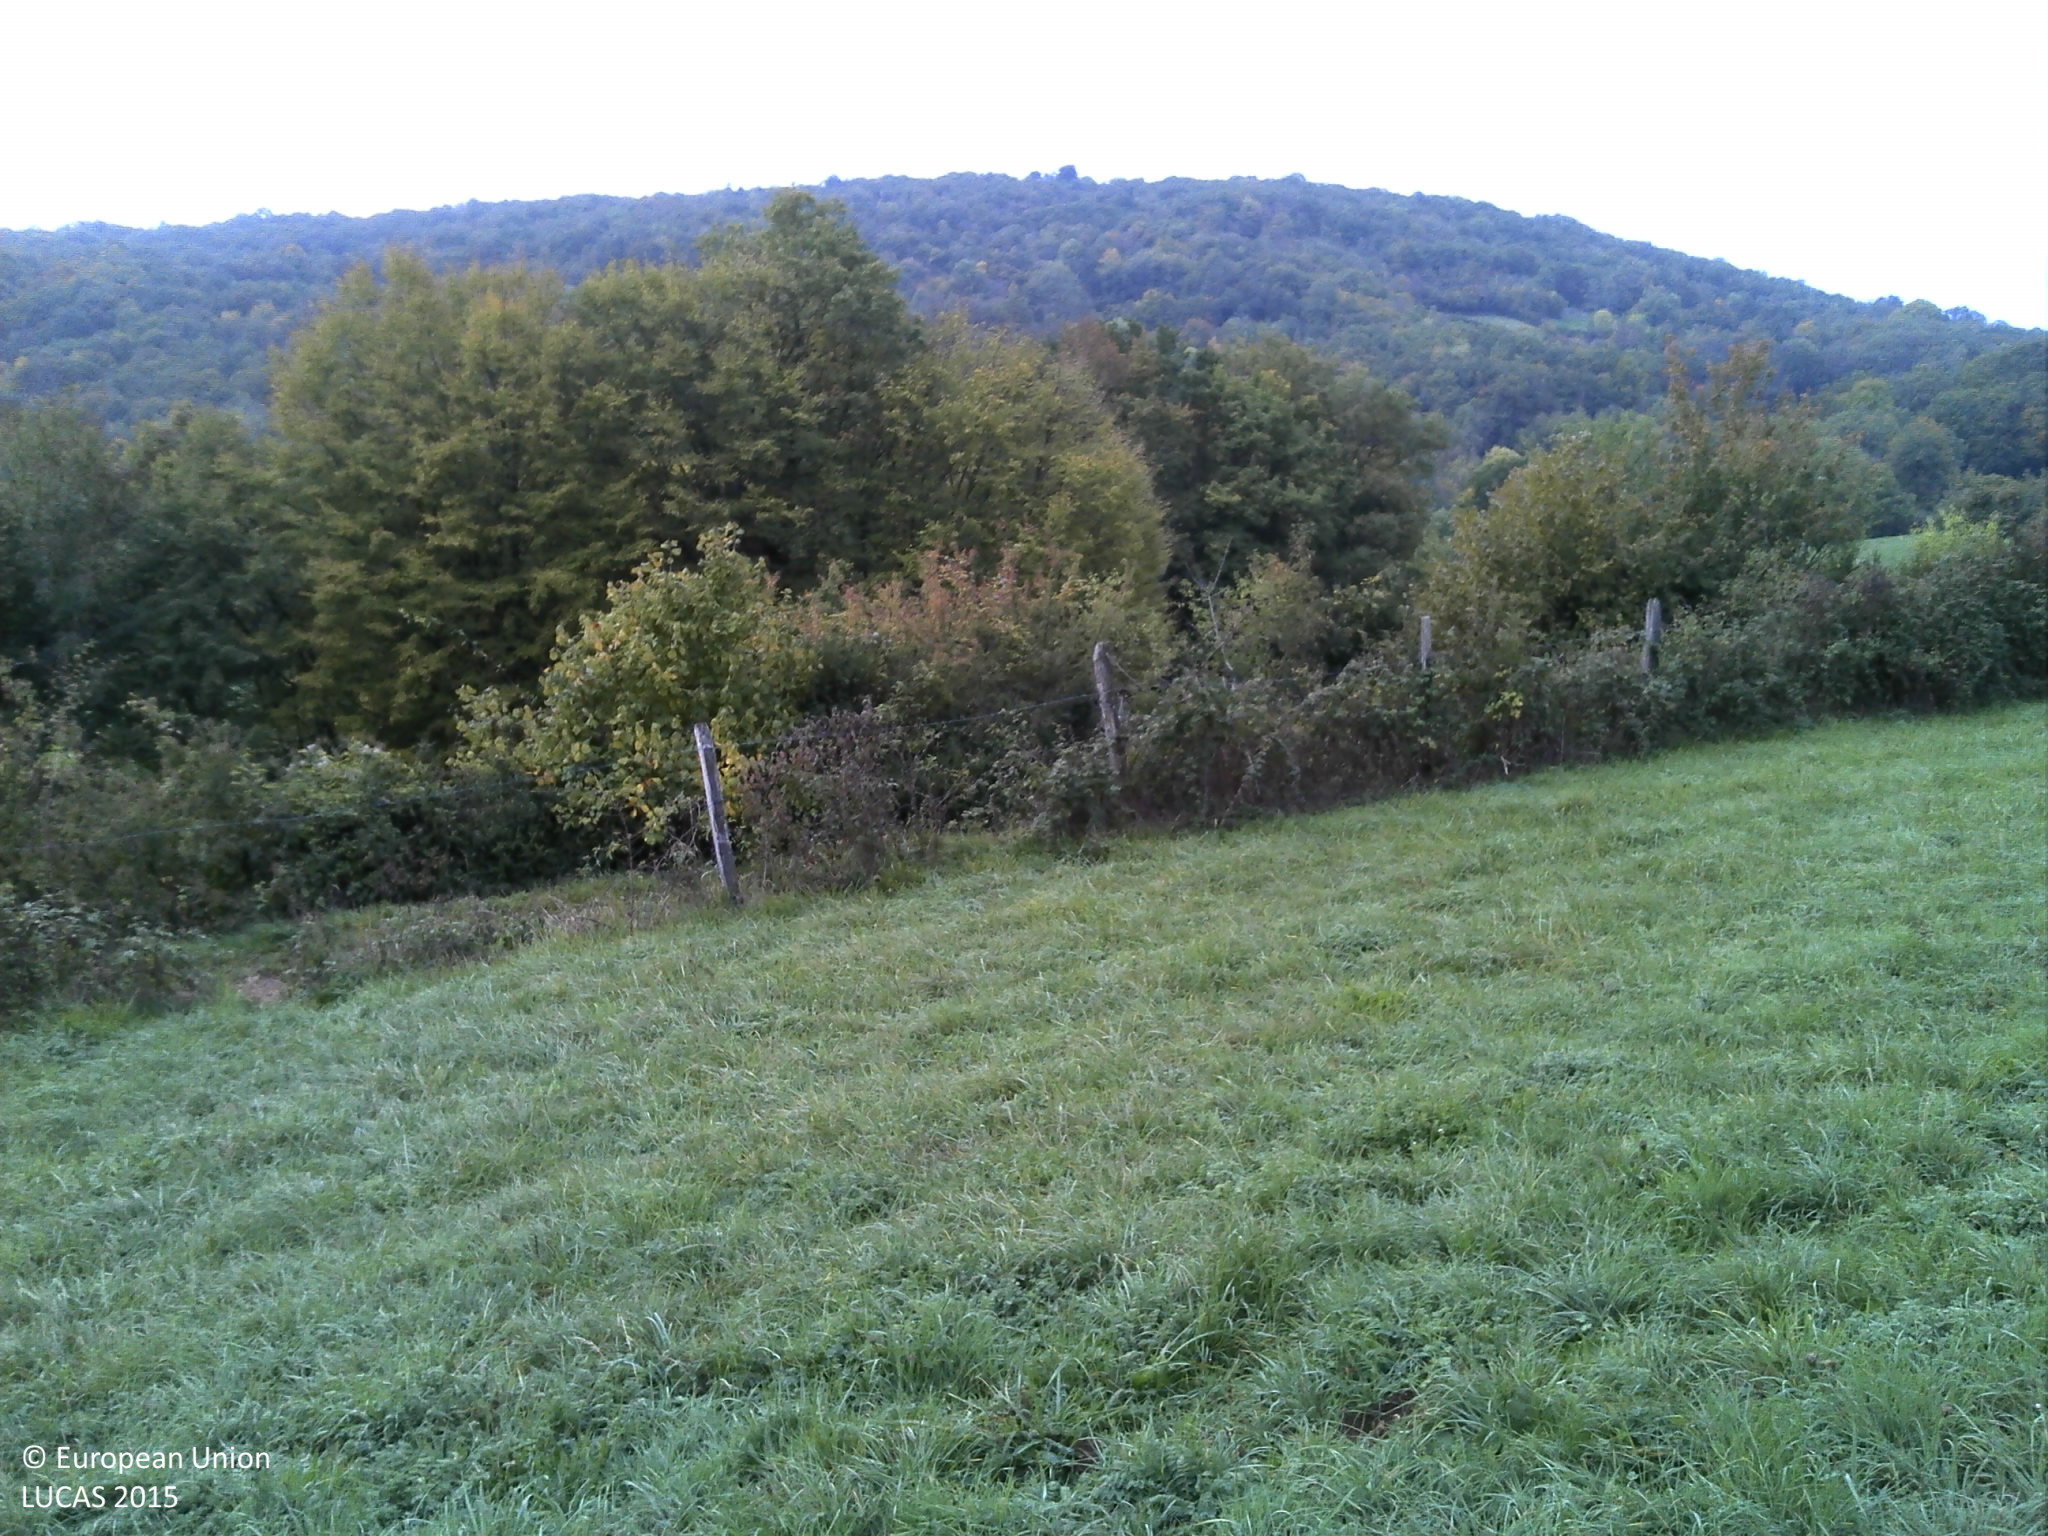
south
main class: Grassland
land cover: Grassland without tree/shrub cover
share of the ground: > 75 %
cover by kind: herbaceous plants 100 %
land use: Agriculture (excluding fallow land and kitchen gardens)
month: October
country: FR
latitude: 46.1242
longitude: 5.3573
